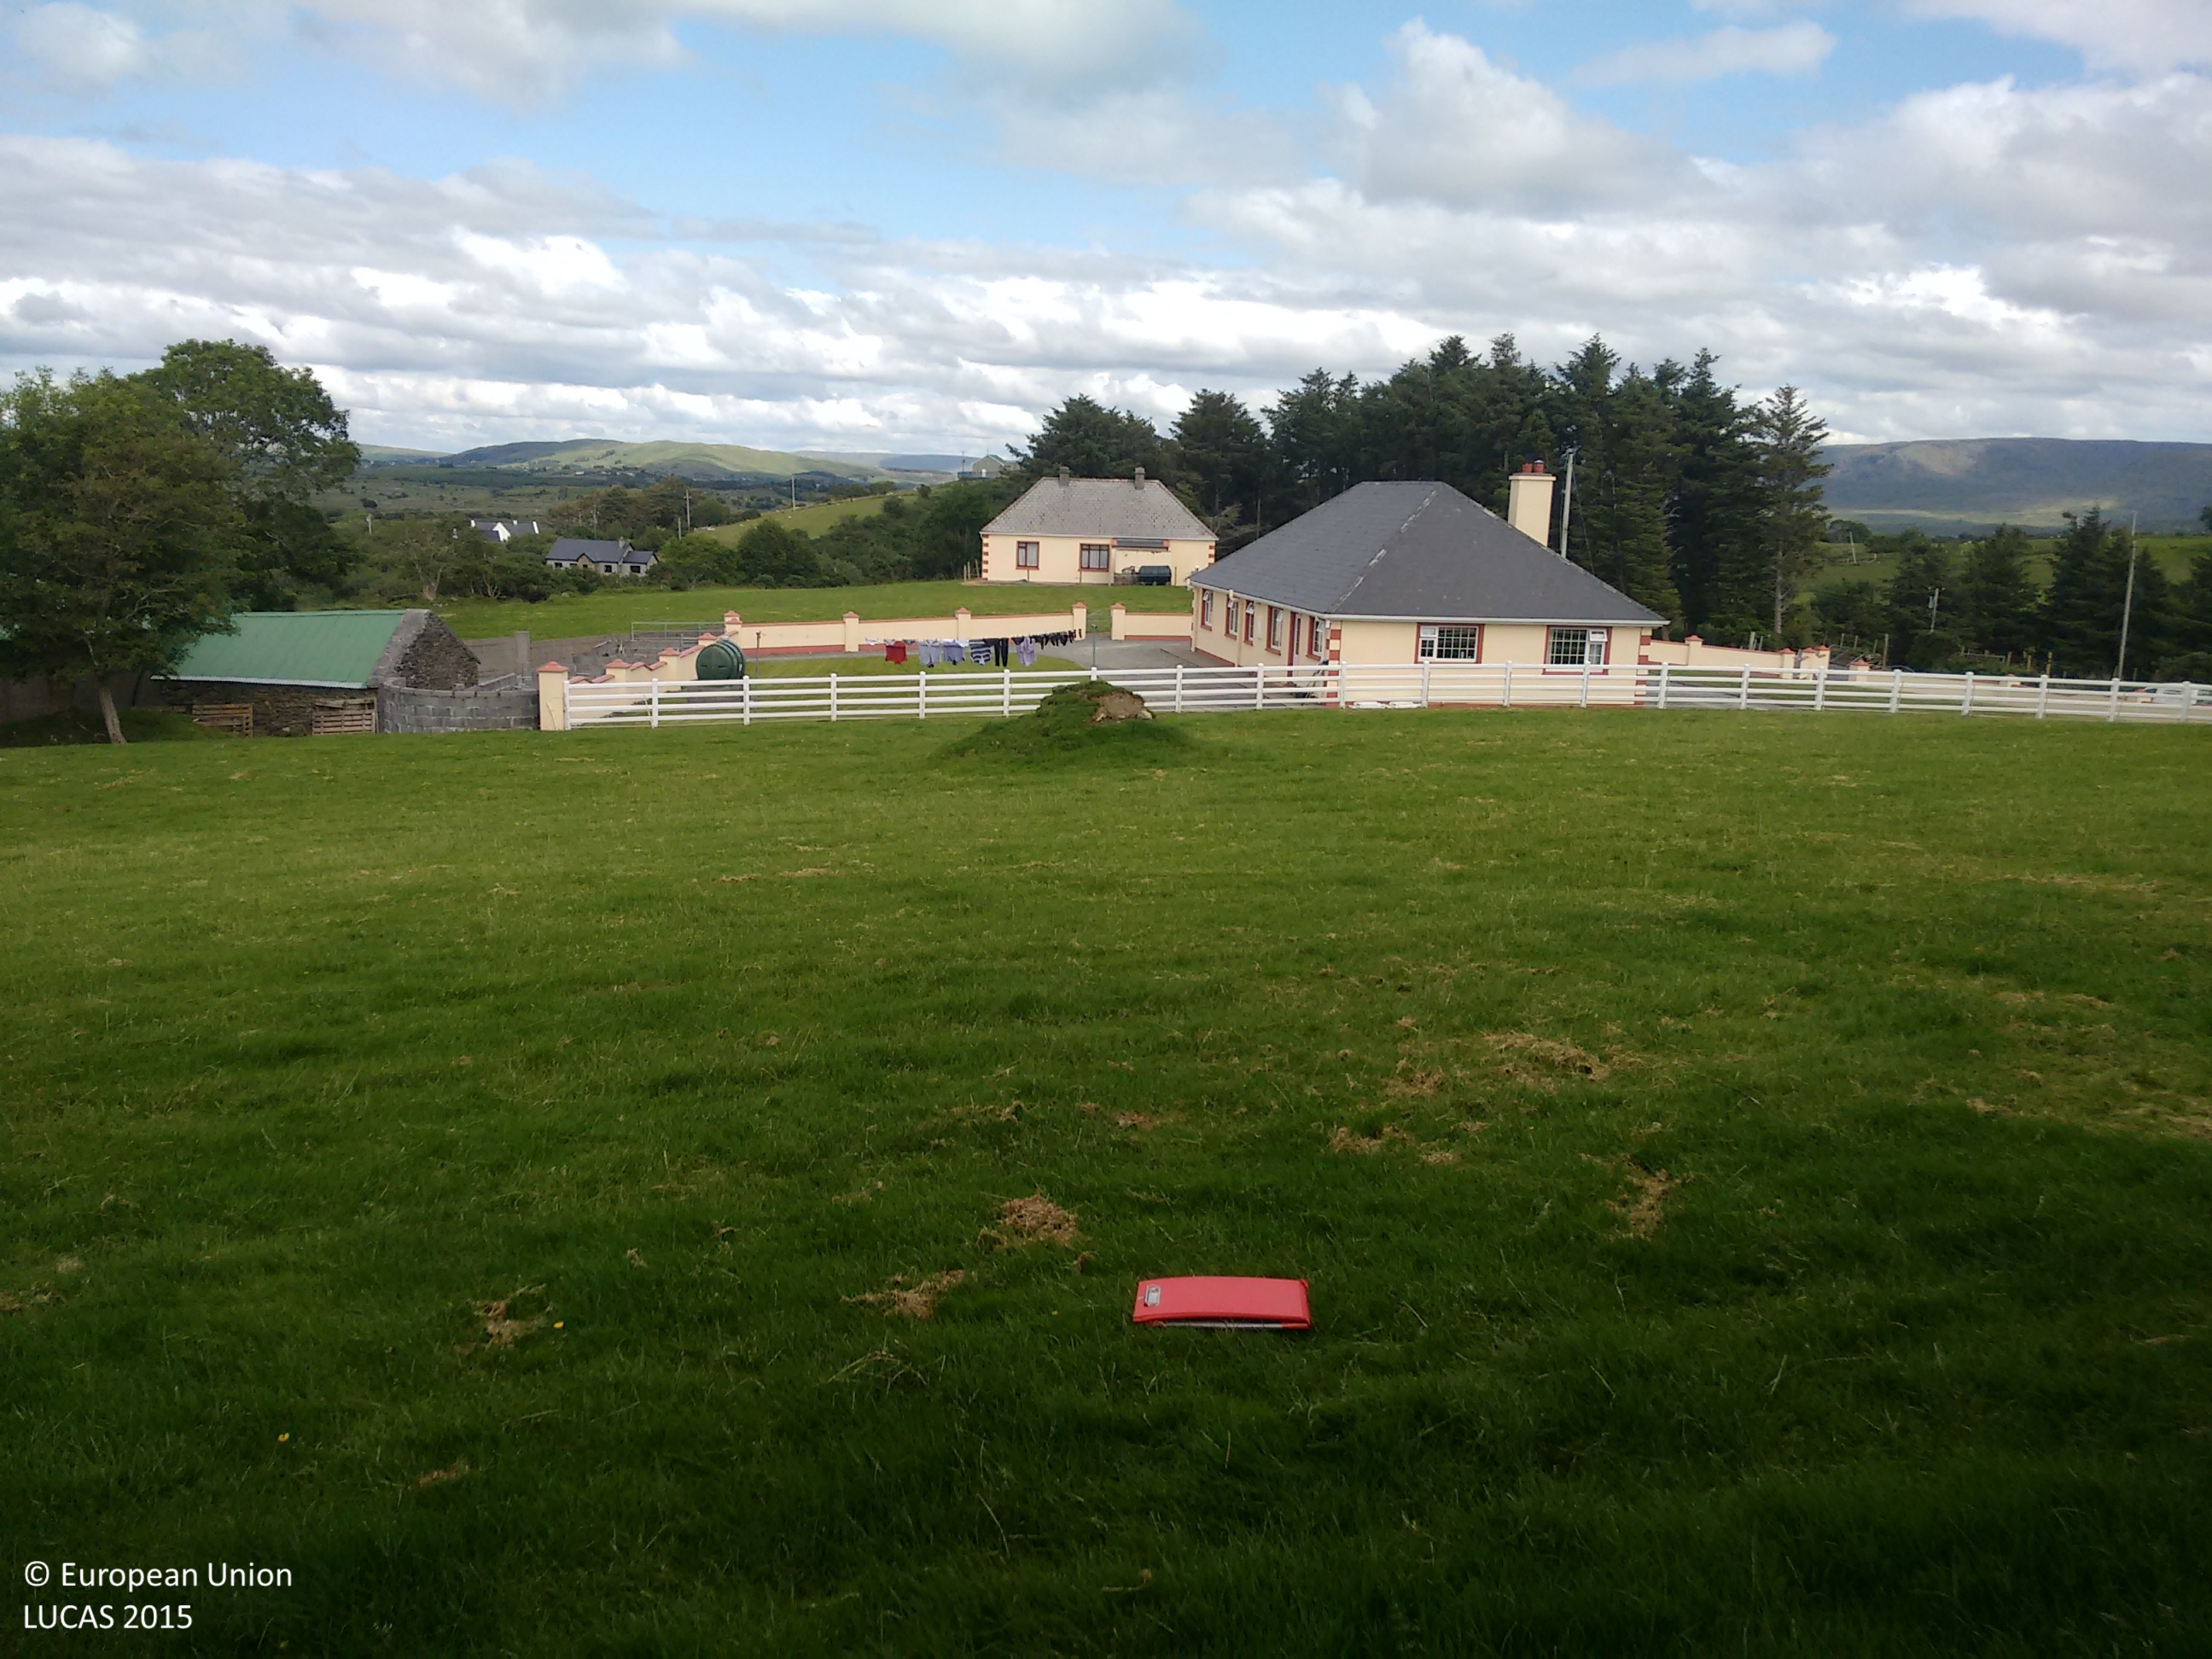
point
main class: Grassland
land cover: Grassland without tree/shrub cover
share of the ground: > 75 %
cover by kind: herbaceous plants 100 %
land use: Agriculture (excluding fallow land and kitchen gardens)
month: July
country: IE
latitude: 53.6982
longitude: -9.6405
